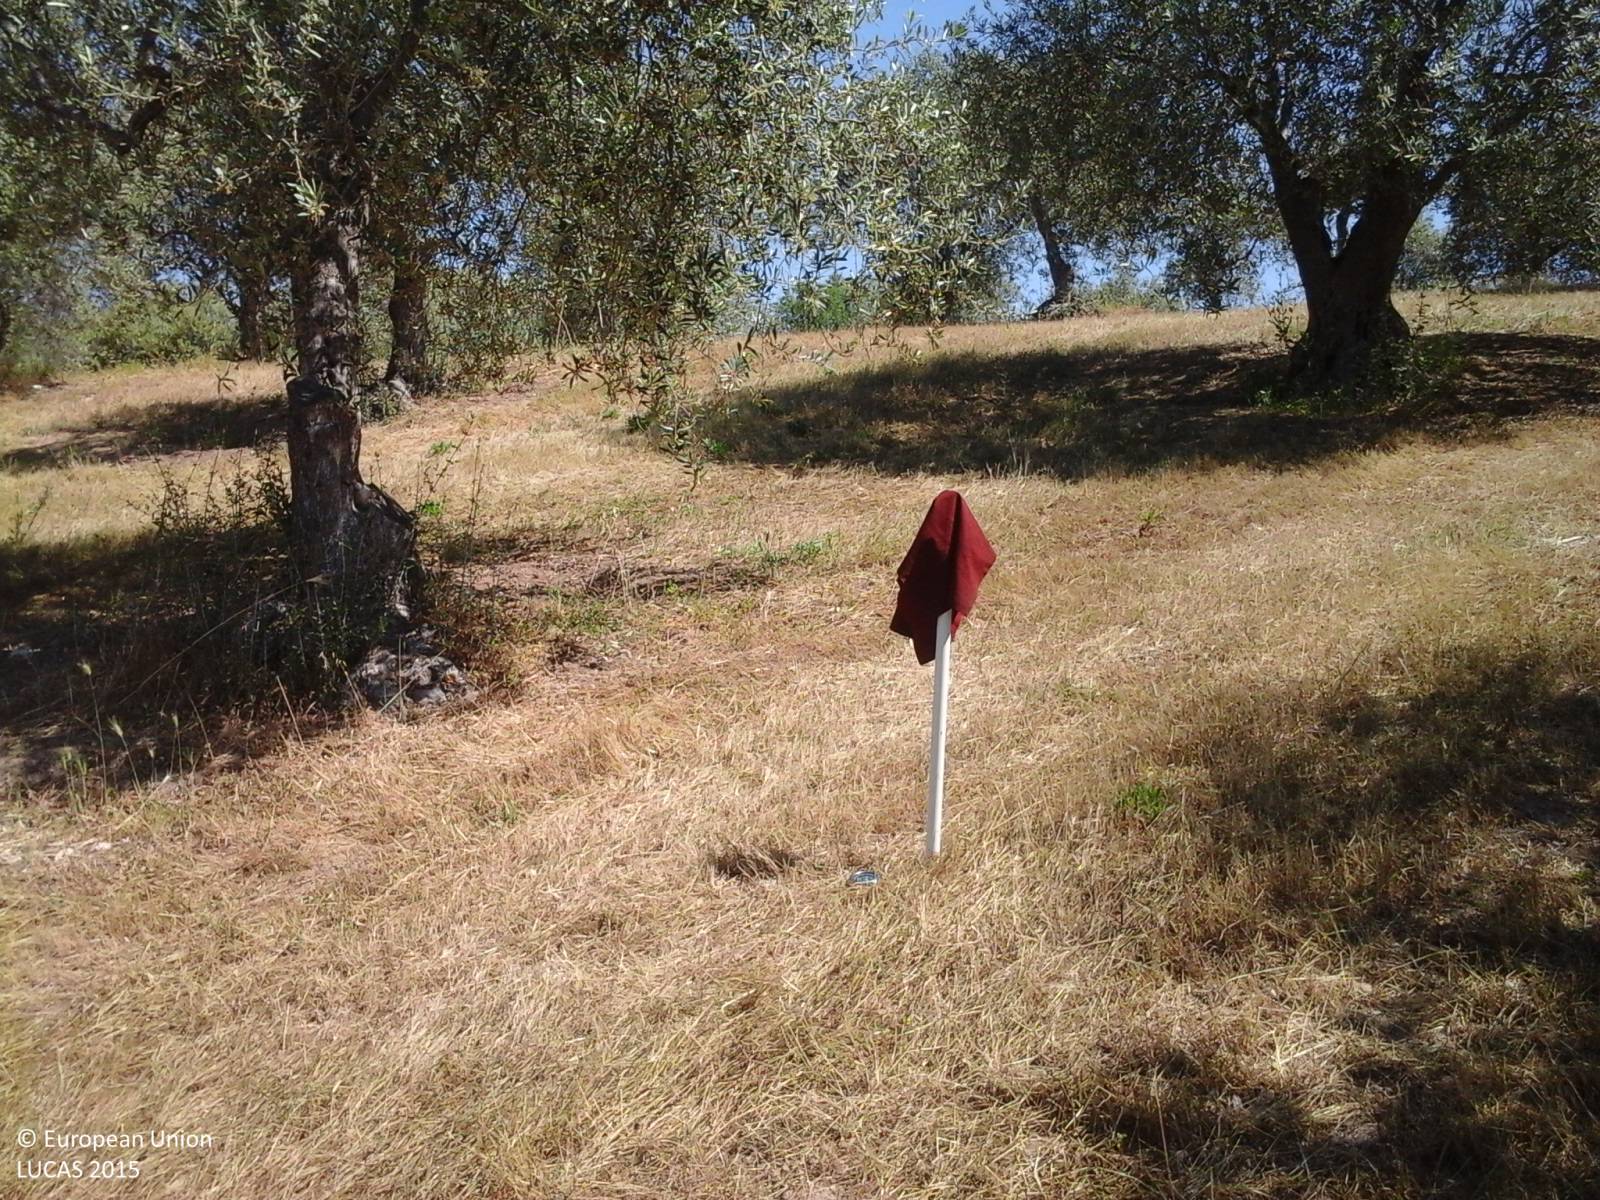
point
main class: Cropland
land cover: Olive groves
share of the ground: 25 - 50 %
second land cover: Spontaneously vegetated surfaces
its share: 50 - 75 %
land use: Agriculture (excluding fallow land and kitchen gardens)
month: May
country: IT
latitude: 40.6538
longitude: 8.4817
